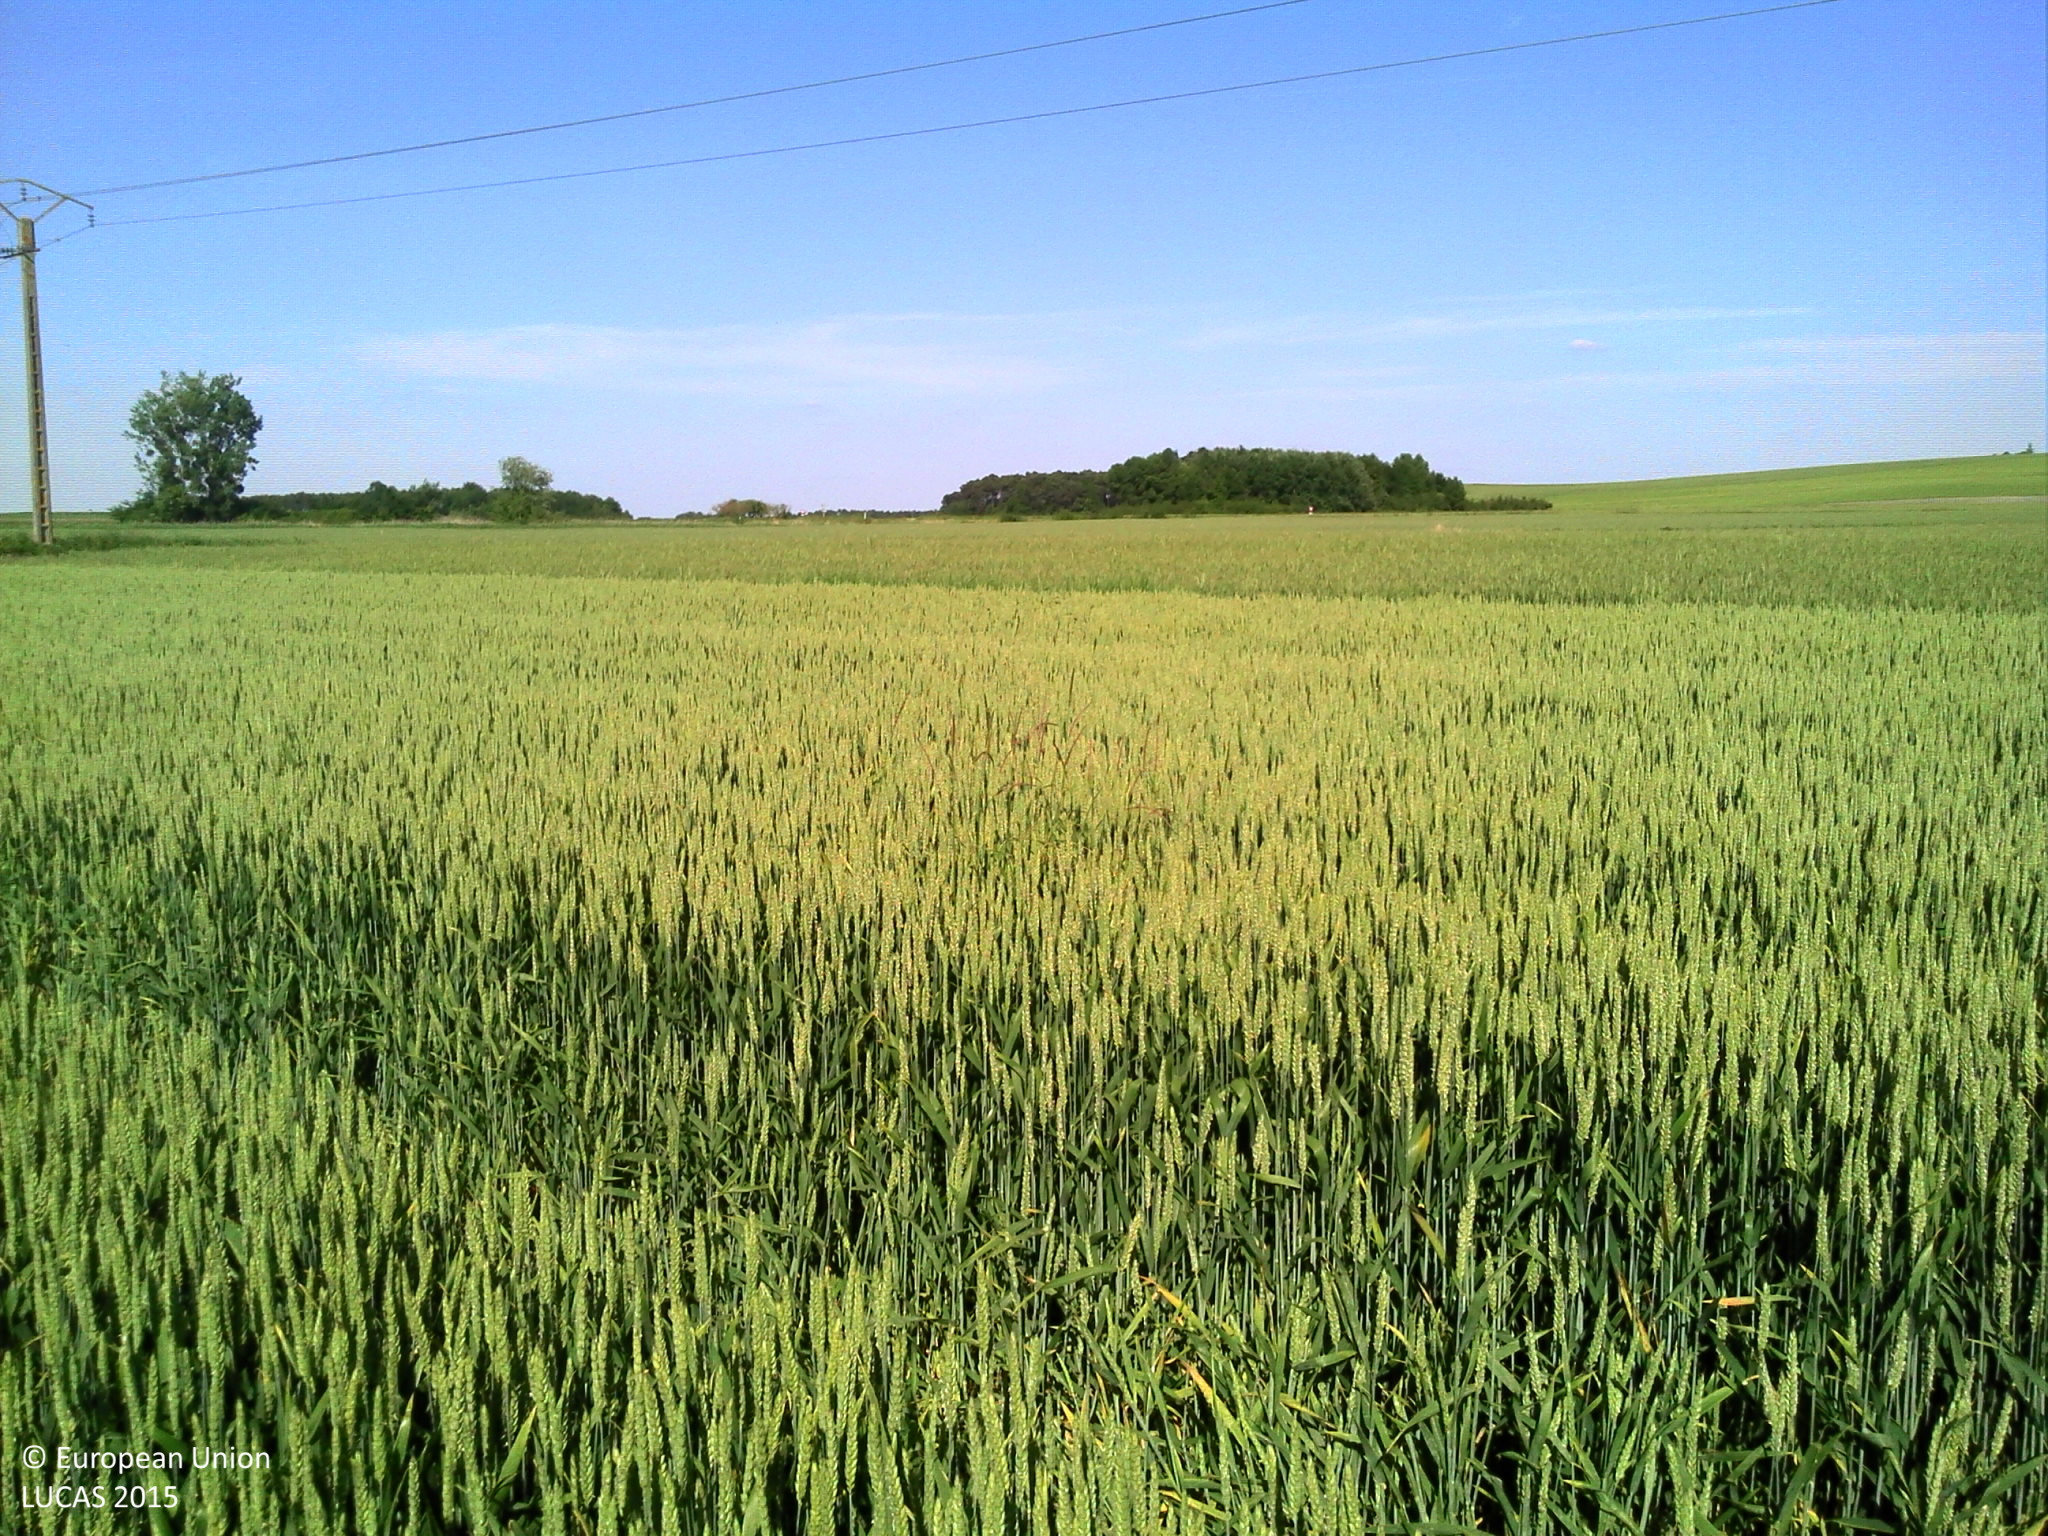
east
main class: Cropland
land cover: Common wheat
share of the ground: > 75 %
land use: Agriculture (excluding fallow land and kitchen gardens)
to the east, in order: Common wheat; Electric lines; Common wheat; Grass margins; Ditches and canals; Grass margins; Common wheat; Grass margins; Ditches and canals; Grass margins; Common wheat
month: May
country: FR
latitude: 46.8239
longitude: 0.1867
